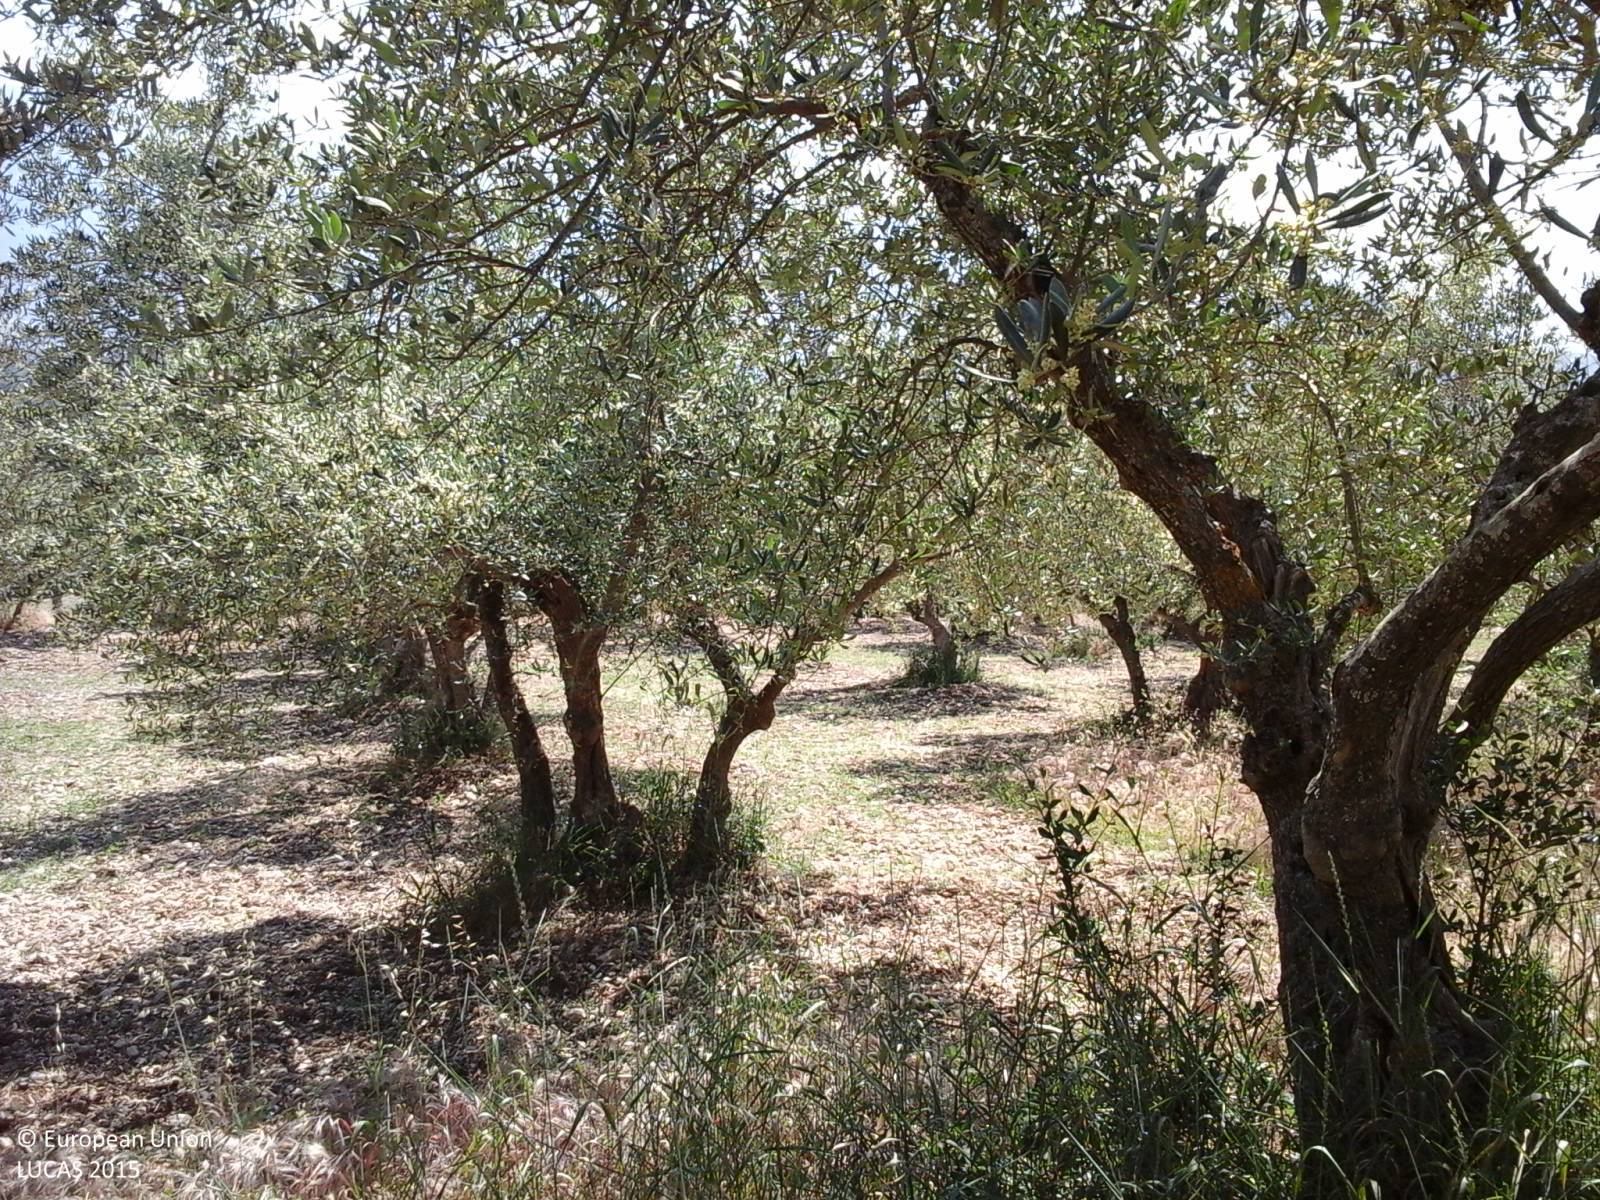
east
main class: Cropland
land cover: Olive groves
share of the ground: 25 - 50 %
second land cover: Spontaneously vegetated surfaces
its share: 50 - 75 %
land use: Abandoned areas
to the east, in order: Olive groves; Spontaneously vegetated surfaces; Managed hedges; Other bare soil; Single bushes/trees; Other bare soil; Broadleaved woodland; Other bare soil; Tracks; Grassland without tree/shrub cover; Olive groves; Barley; Olive groves
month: June
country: IT
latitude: 42.0757
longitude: 13.8189
